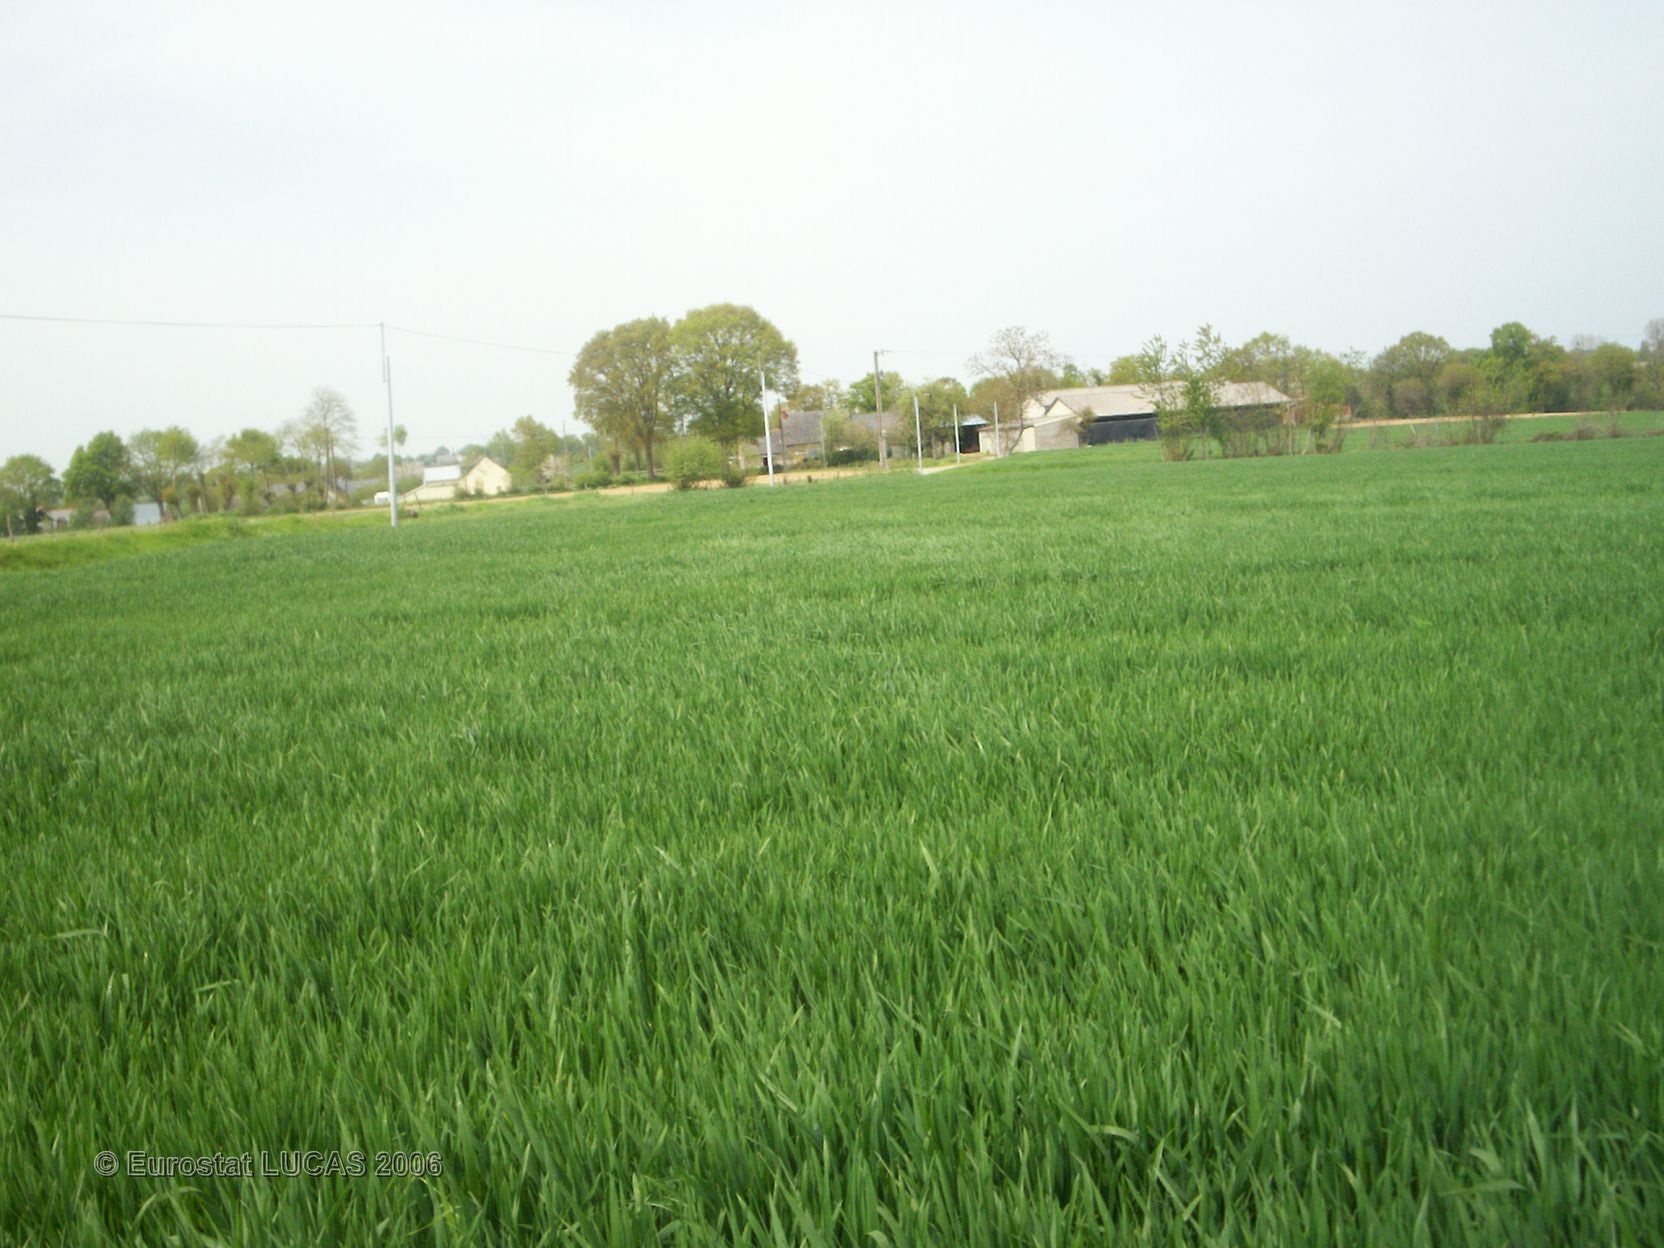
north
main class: Cropland
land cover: Common wheat
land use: Agriculture (excluding fallow land and kitchen gardens)
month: May
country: FR
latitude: 47.9135
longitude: -1.2949
